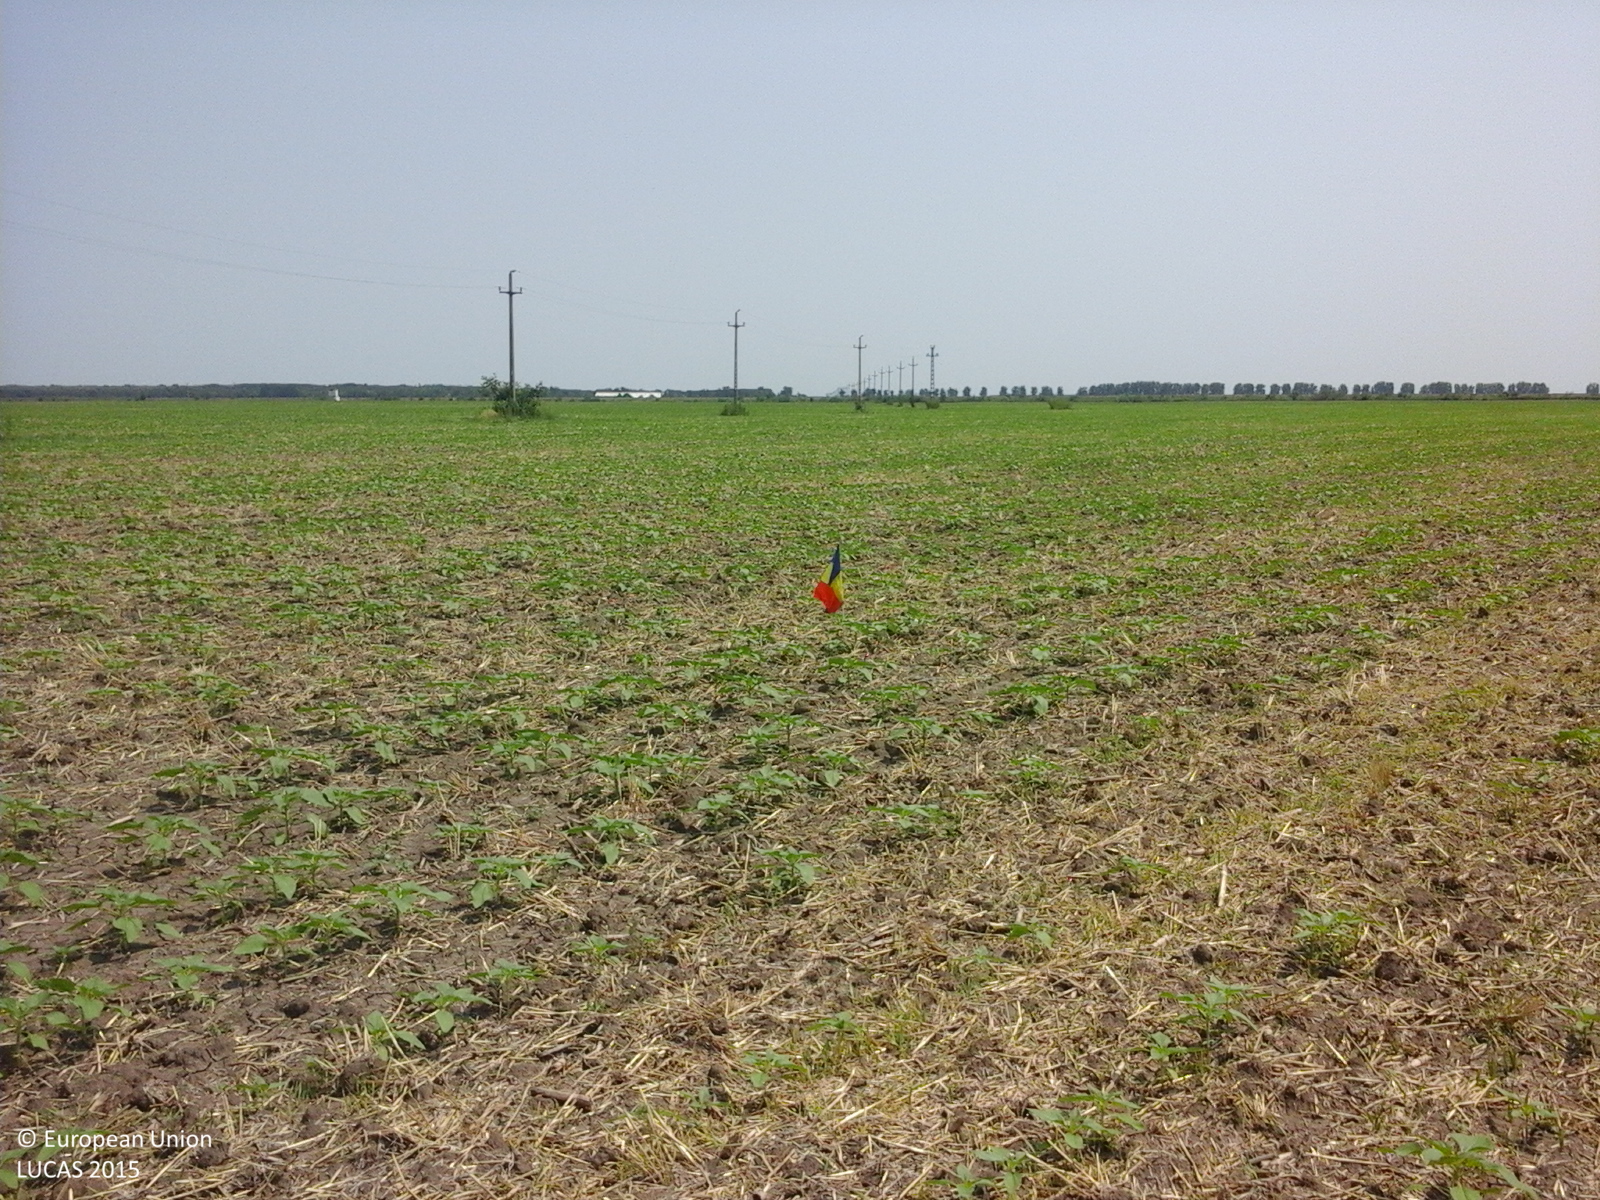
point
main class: Cropland
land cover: Sunflower
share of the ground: 25 - 50 %
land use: Agriculture (excluding fallow land and kitchen gardens)
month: July
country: RO
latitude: 44.5701
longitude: 26.6796
